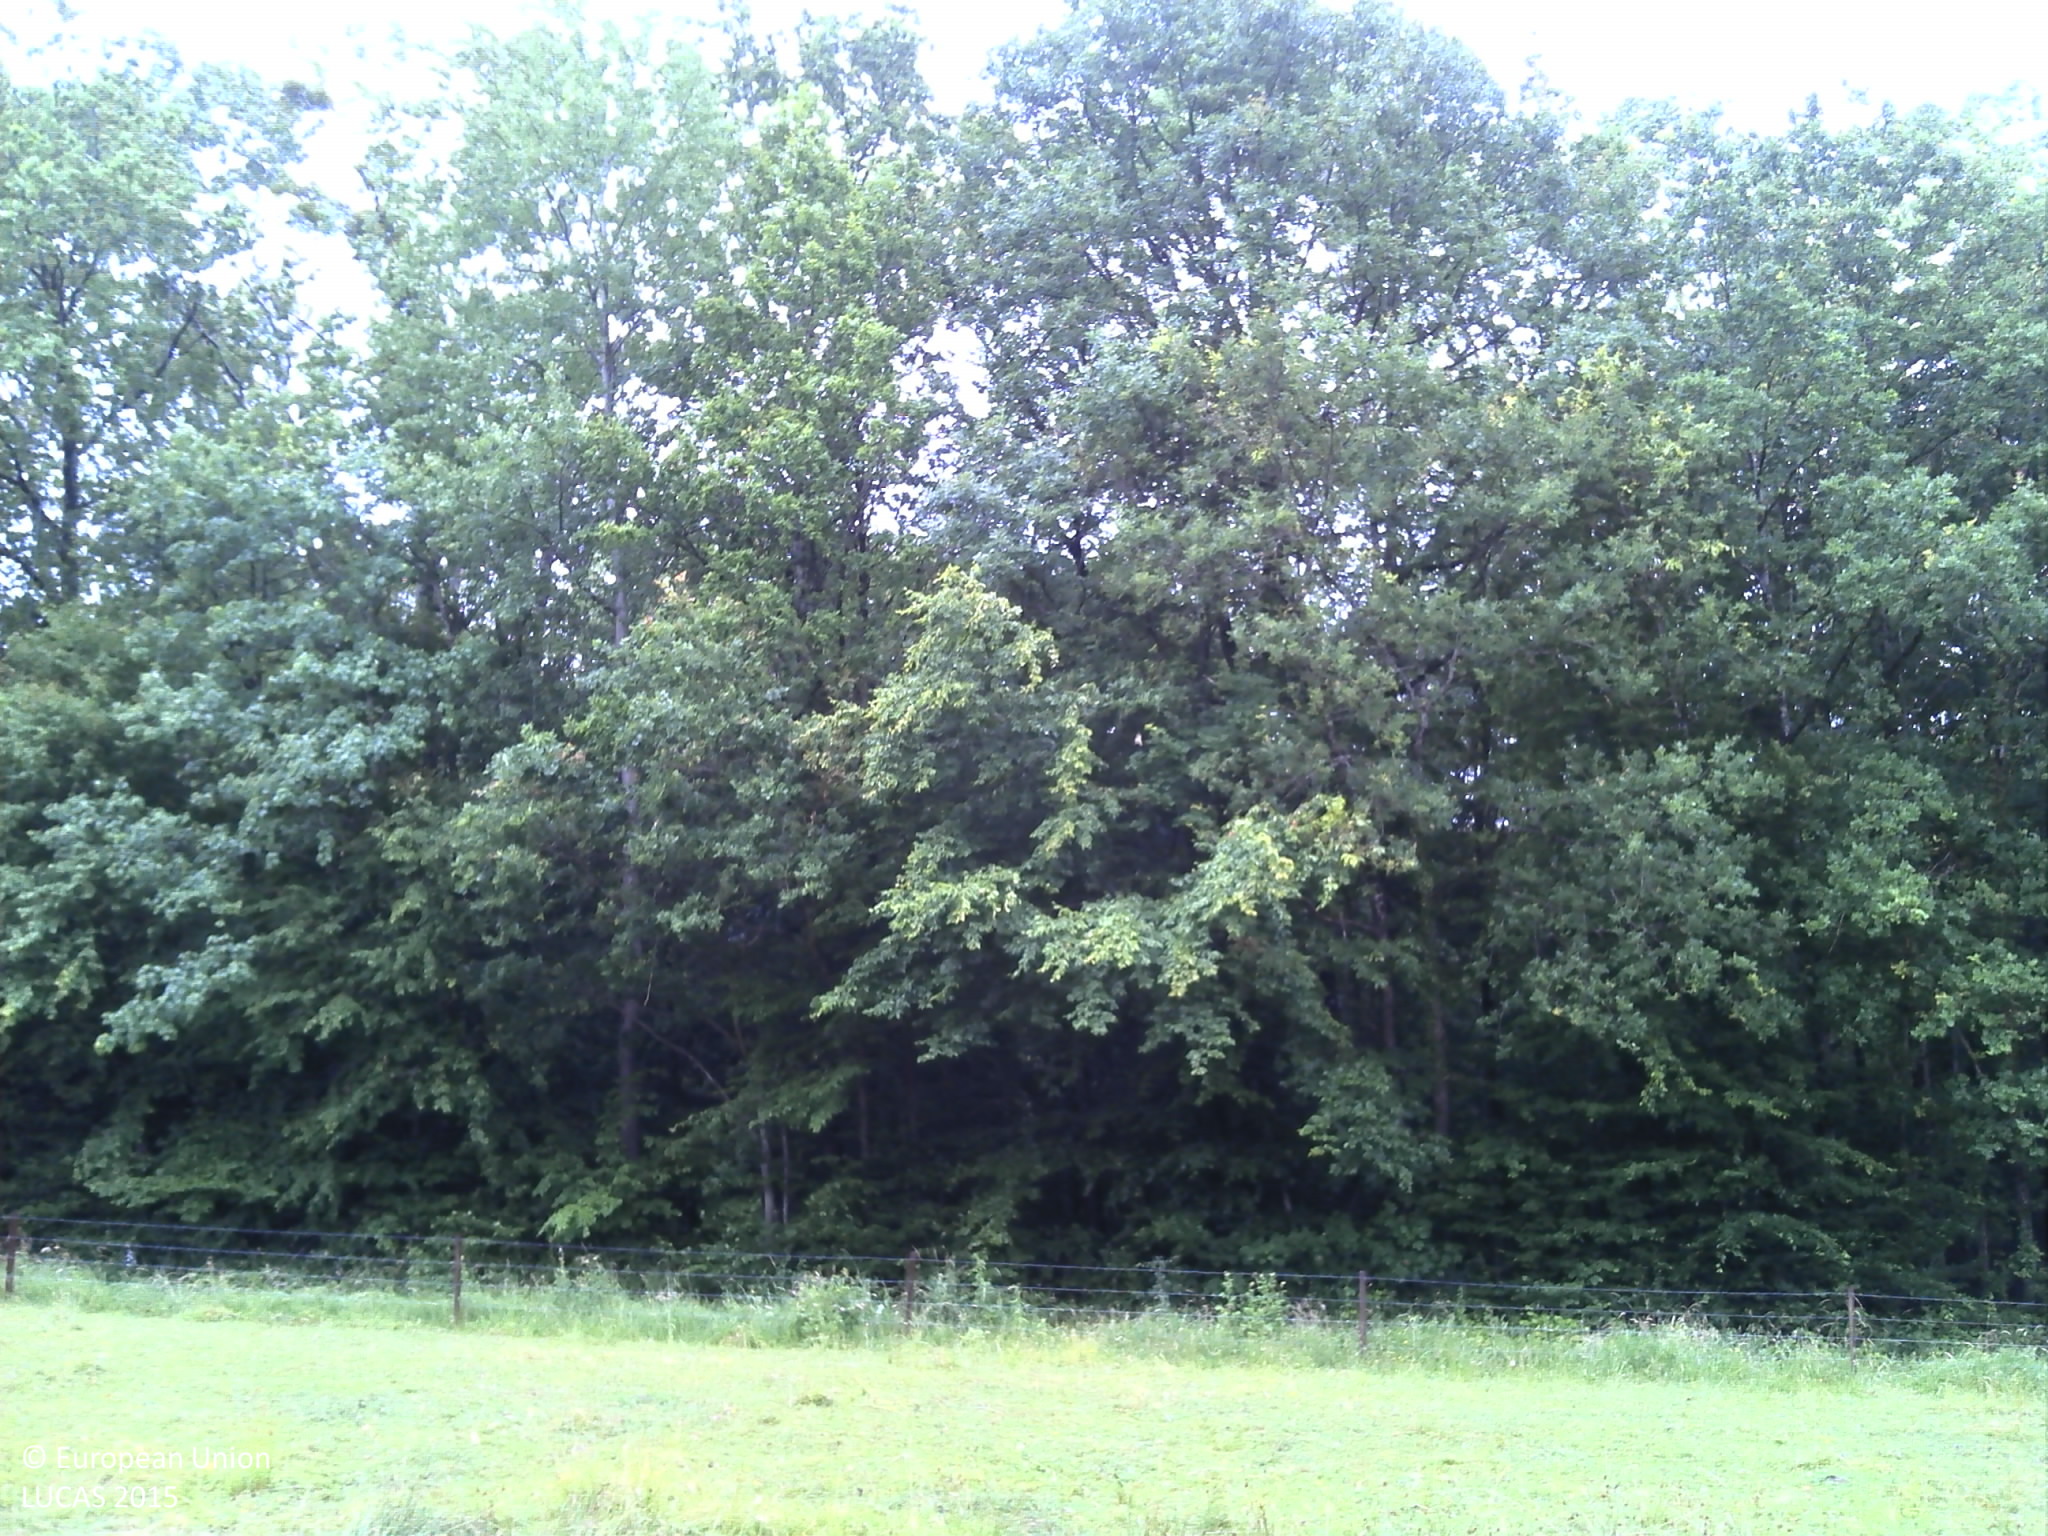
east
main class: Grassland
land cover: Grassland without tree/shrub cover
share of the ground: > 75 %
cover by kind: herbaceous plants 100 %
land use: Agriculture (excluding fallow land and kitchen gardens)
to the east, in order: Grassland without tree/shrub cover; Fences; Paved roads, cycling and walking lanes; Broadleaved woodland; Tracks; Broadleaved woodland; Tracks; Broadleaved woodland; Grassland without tree/shrub cover
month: June
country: FR
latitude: 49.5603
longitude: 4.7849
